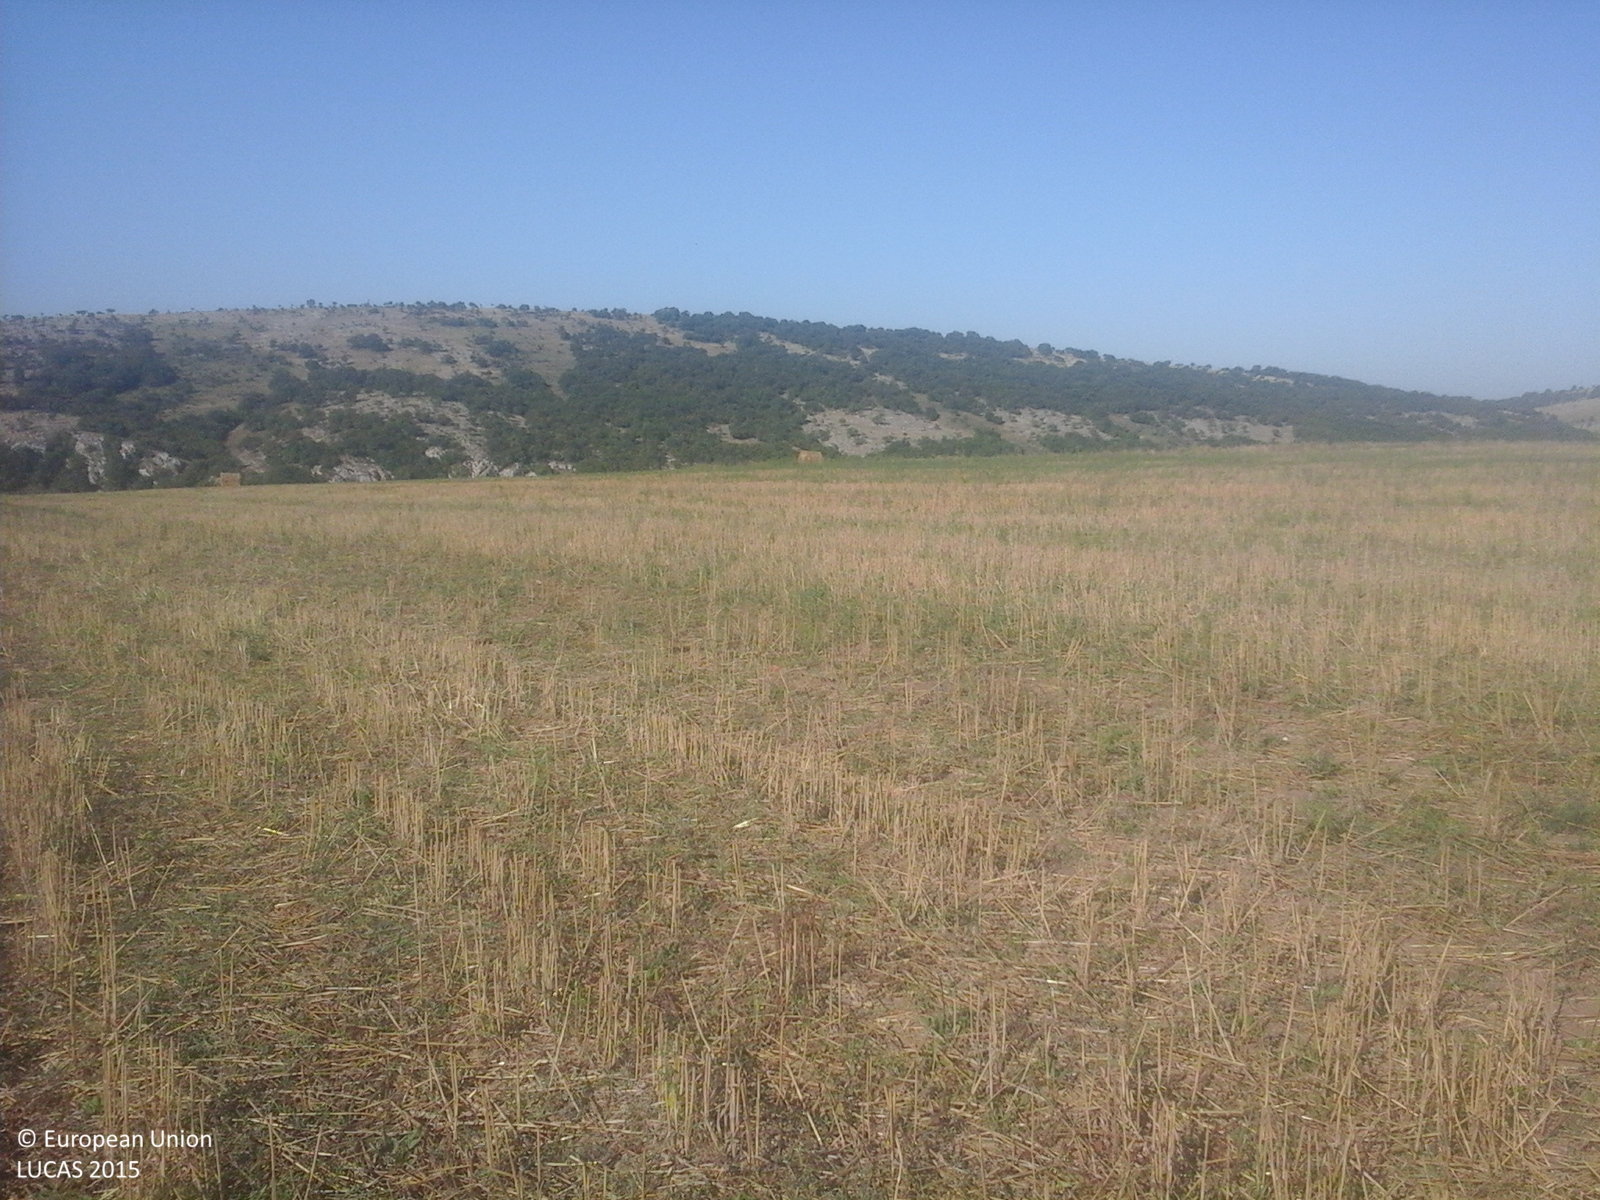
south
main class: Cropland
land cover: Common wheat
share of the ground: > 75 %
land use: Agriculture (excluding fallow land and kitchen gardens)
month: August
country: RO
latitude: 44.5067
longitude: 28.4486
